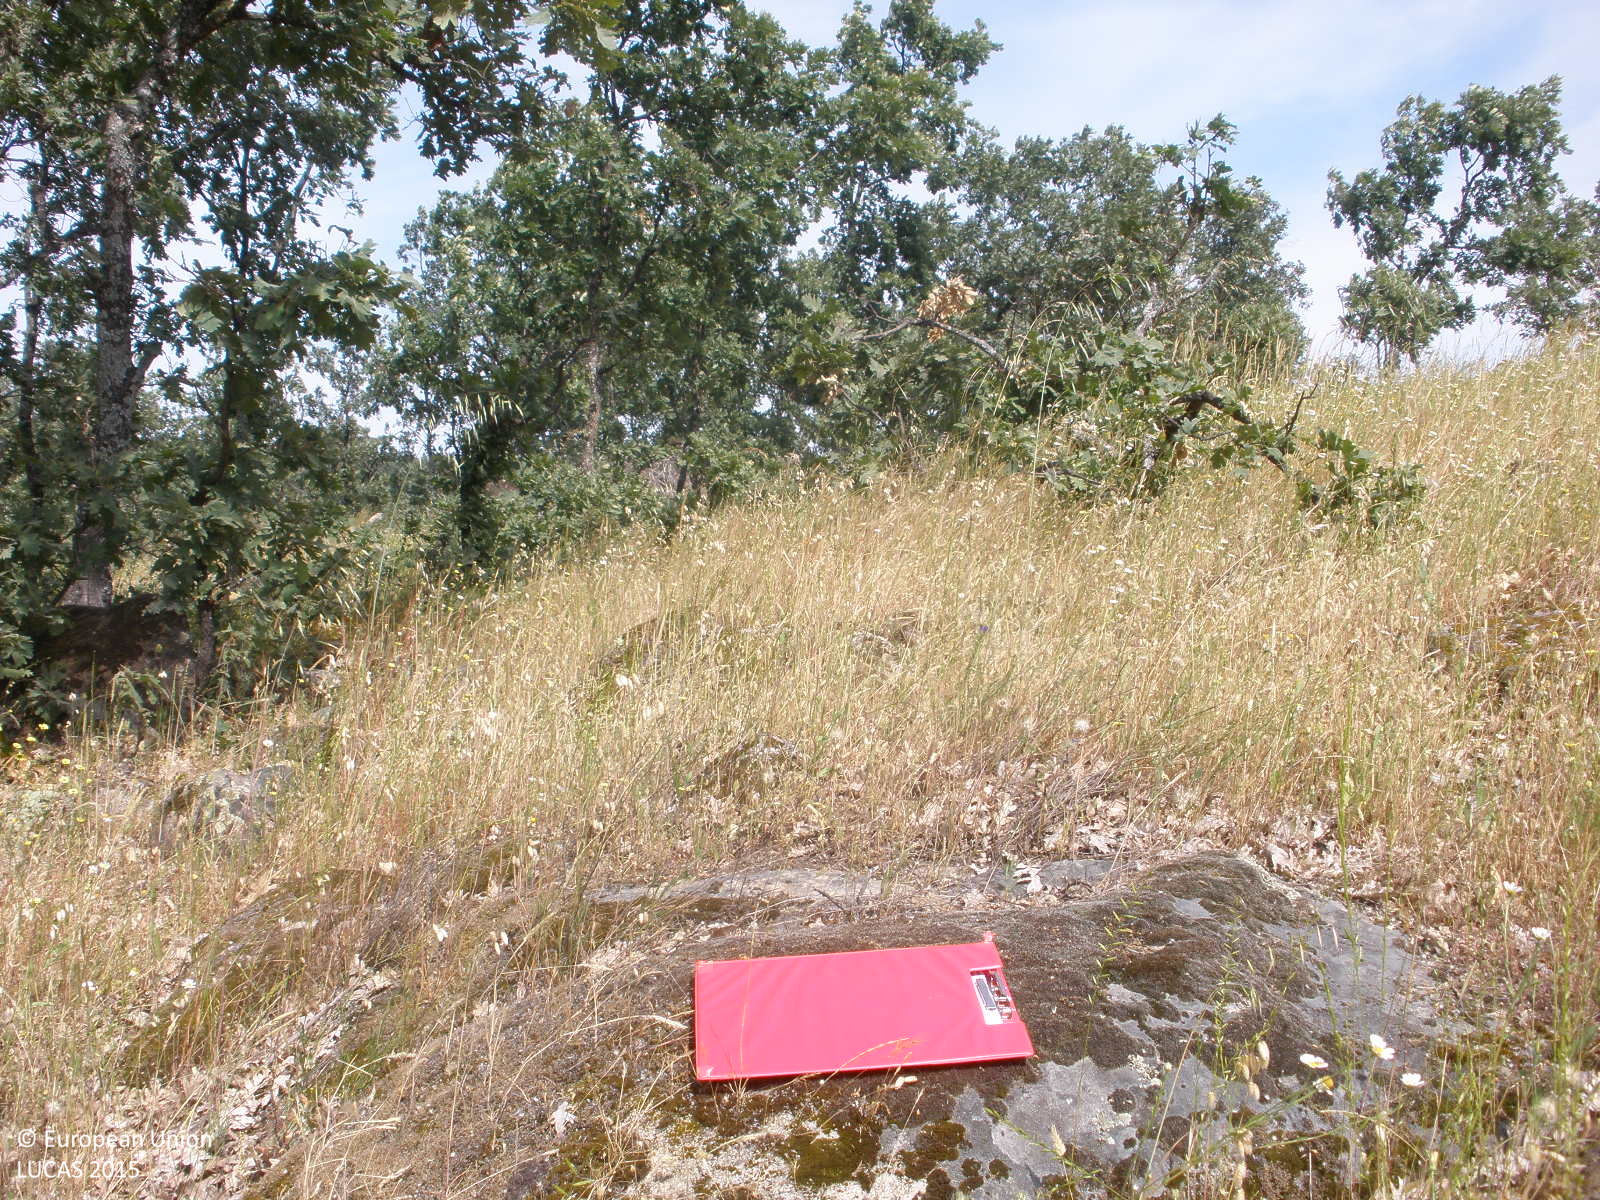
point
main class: Woodland
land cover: Broadleaved woodland
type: thermophilous deciduous forest
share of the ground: 50 - 75 %
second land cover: Grassland without tree/shrub cover
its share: > 75 %
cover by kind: herbaceous plants 50 %, broadleaved forest trees 40 %, consolidated bare surface 10 %
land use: Forestry
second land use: Agriculture (excluding fallow land and kitchen gardens)
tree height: > 5 m
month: May
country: ES
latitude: 40.1715
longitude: -6.5825
